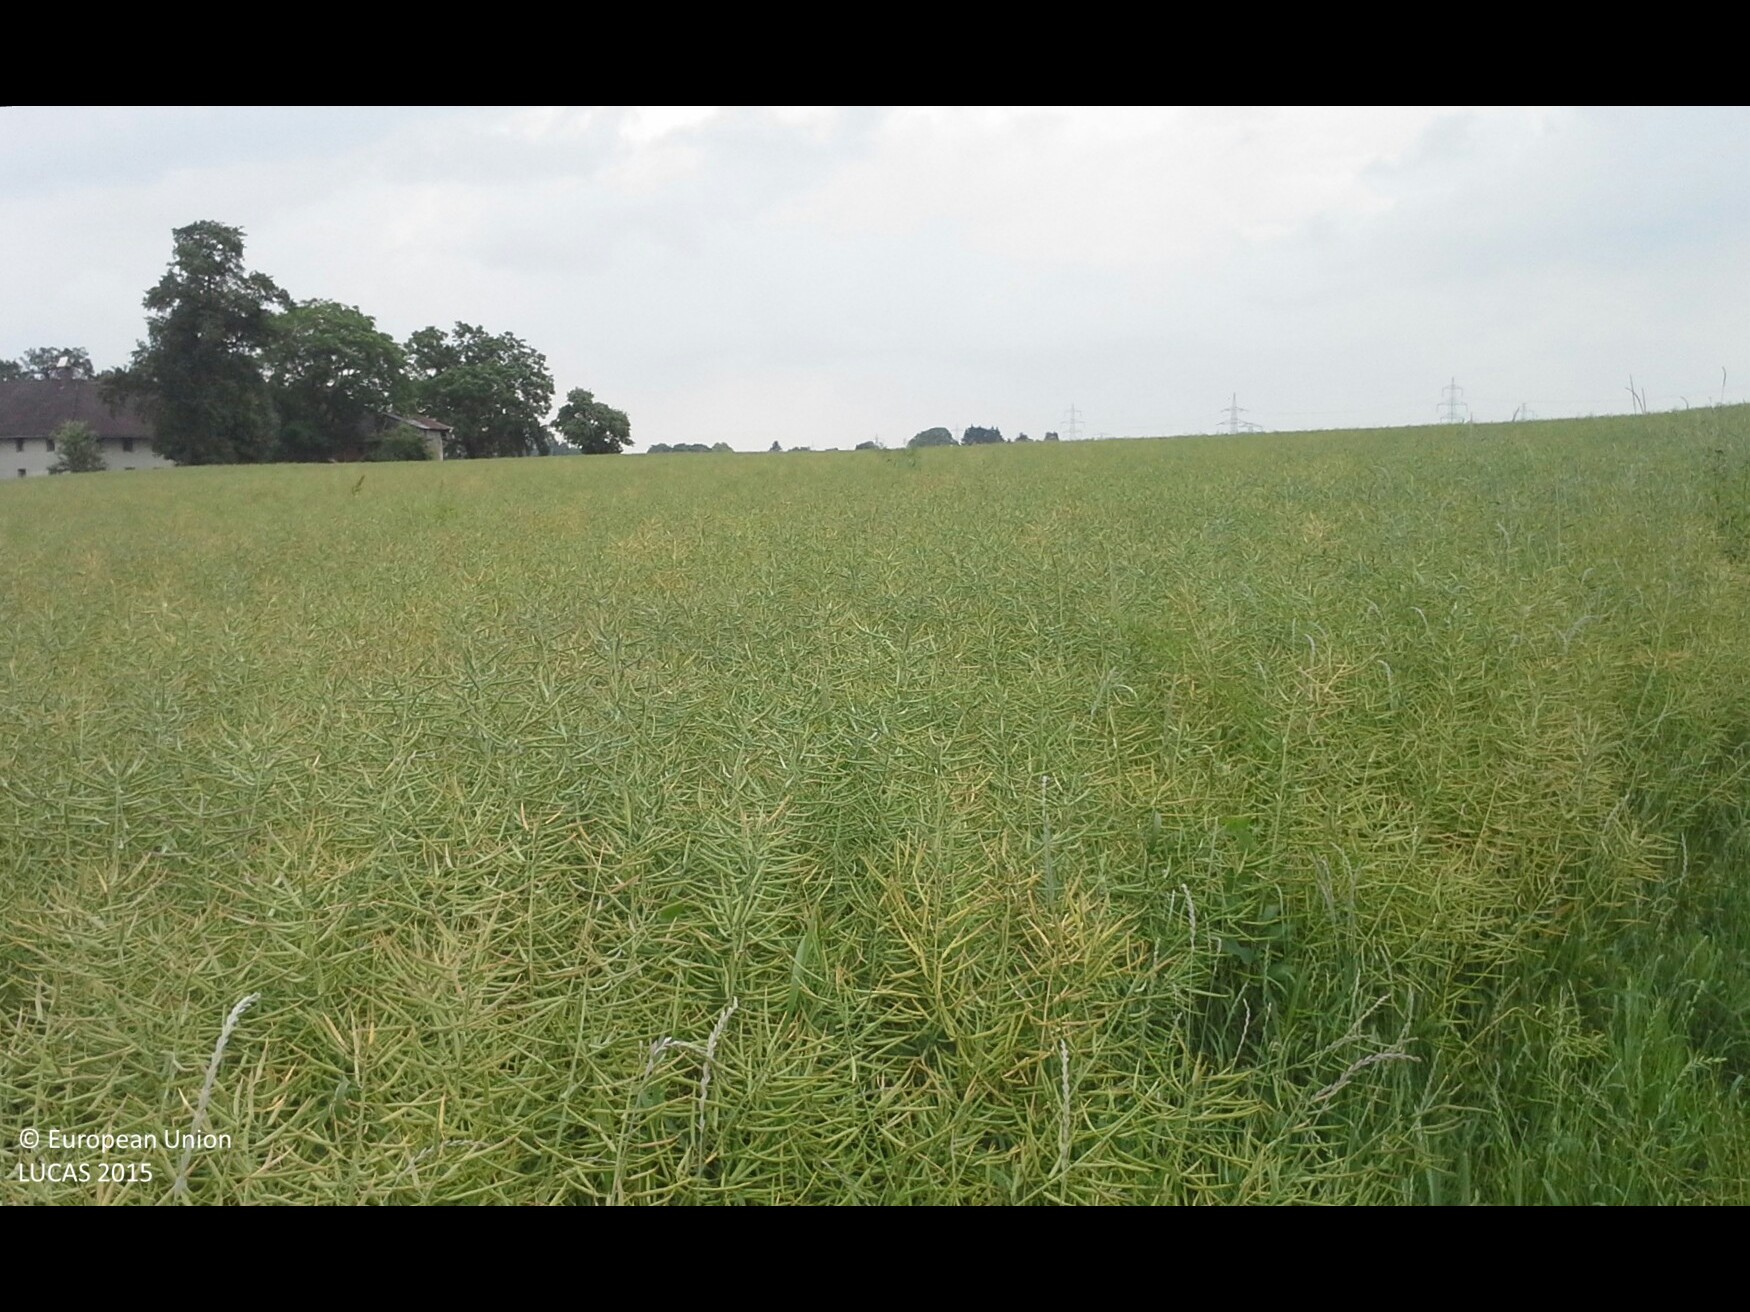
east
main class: Cropland
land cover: Rape and turnip rape
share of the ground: > 75 %
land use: Agriculture (excluding fallow land and kitchen gardens)
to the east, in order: Rape and turnip rape; Artificial constructions in urban areas; Common wheat
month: June
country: AT
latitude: 48.1022
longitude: 14.3375
